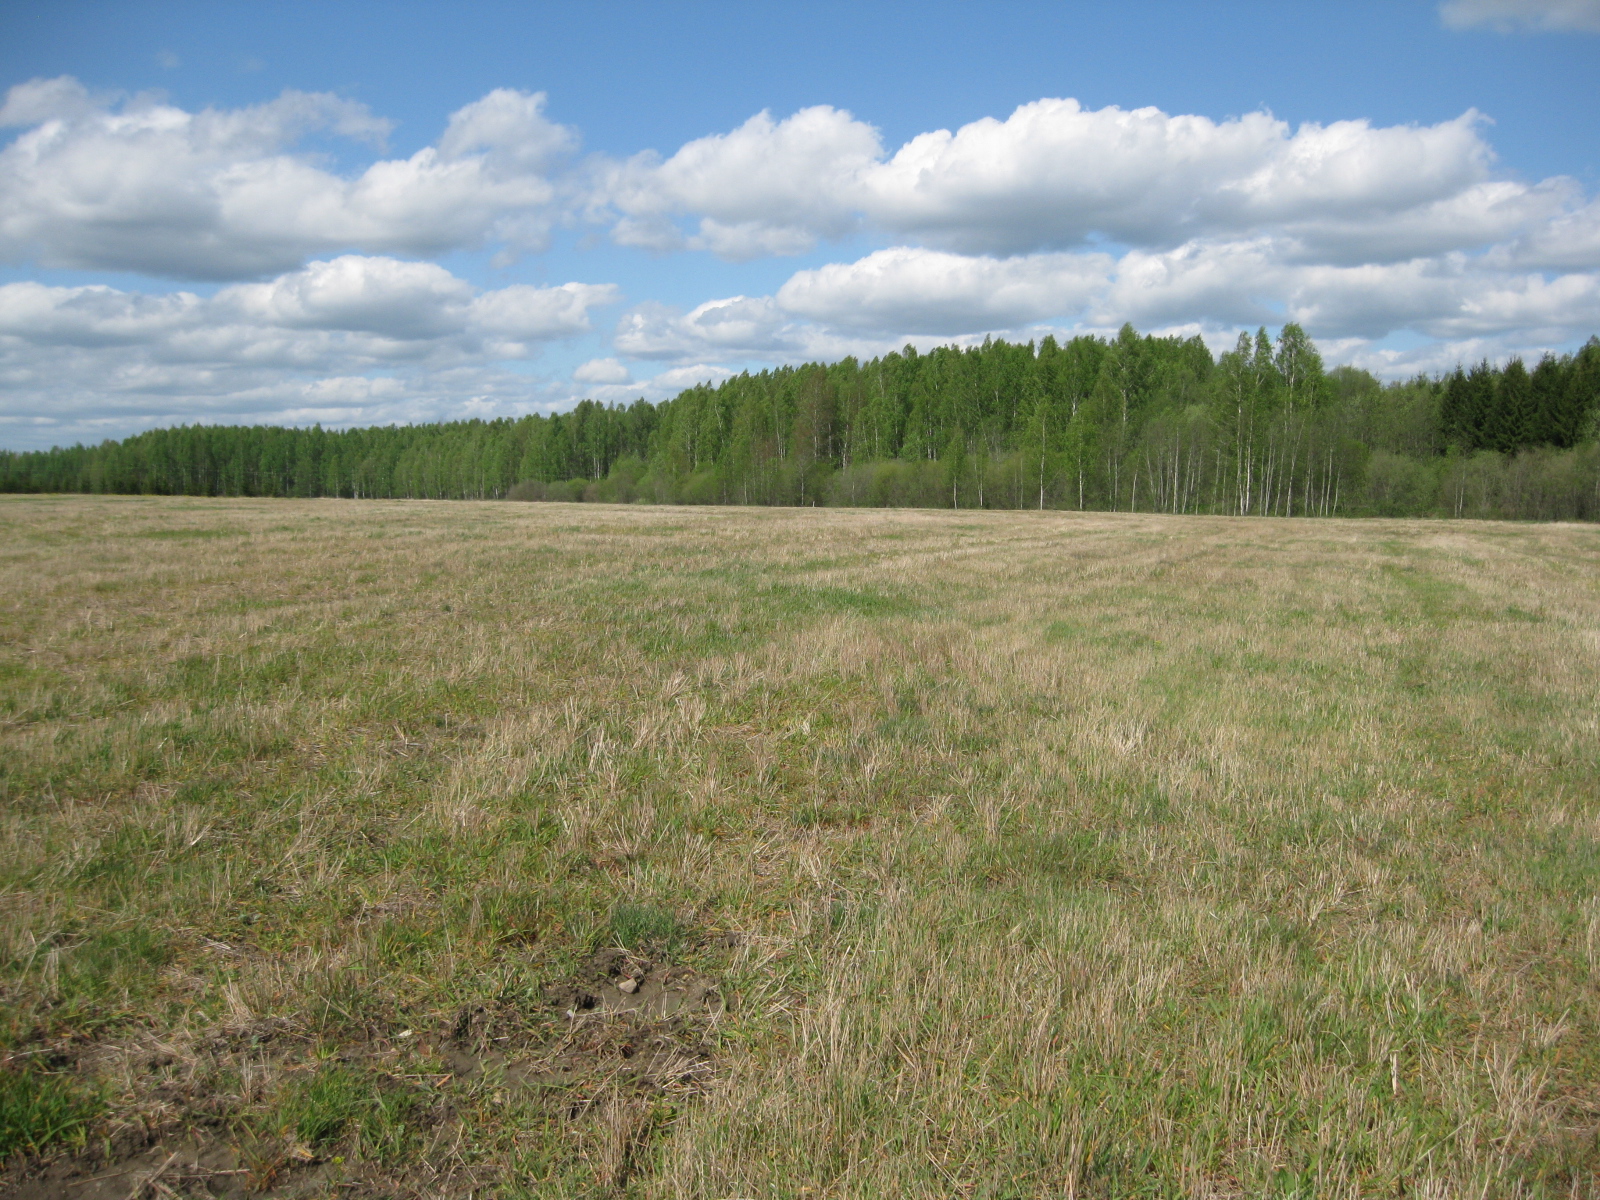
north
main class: Grassland
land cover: Spontaneously vegetated surfaces
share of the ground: > 75 %
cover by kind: herbaceous plants 85 %, unconsolidated bare surface 15 %
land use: Fallow land
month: May
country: LT
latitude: 56.2023
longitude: 24.9536
